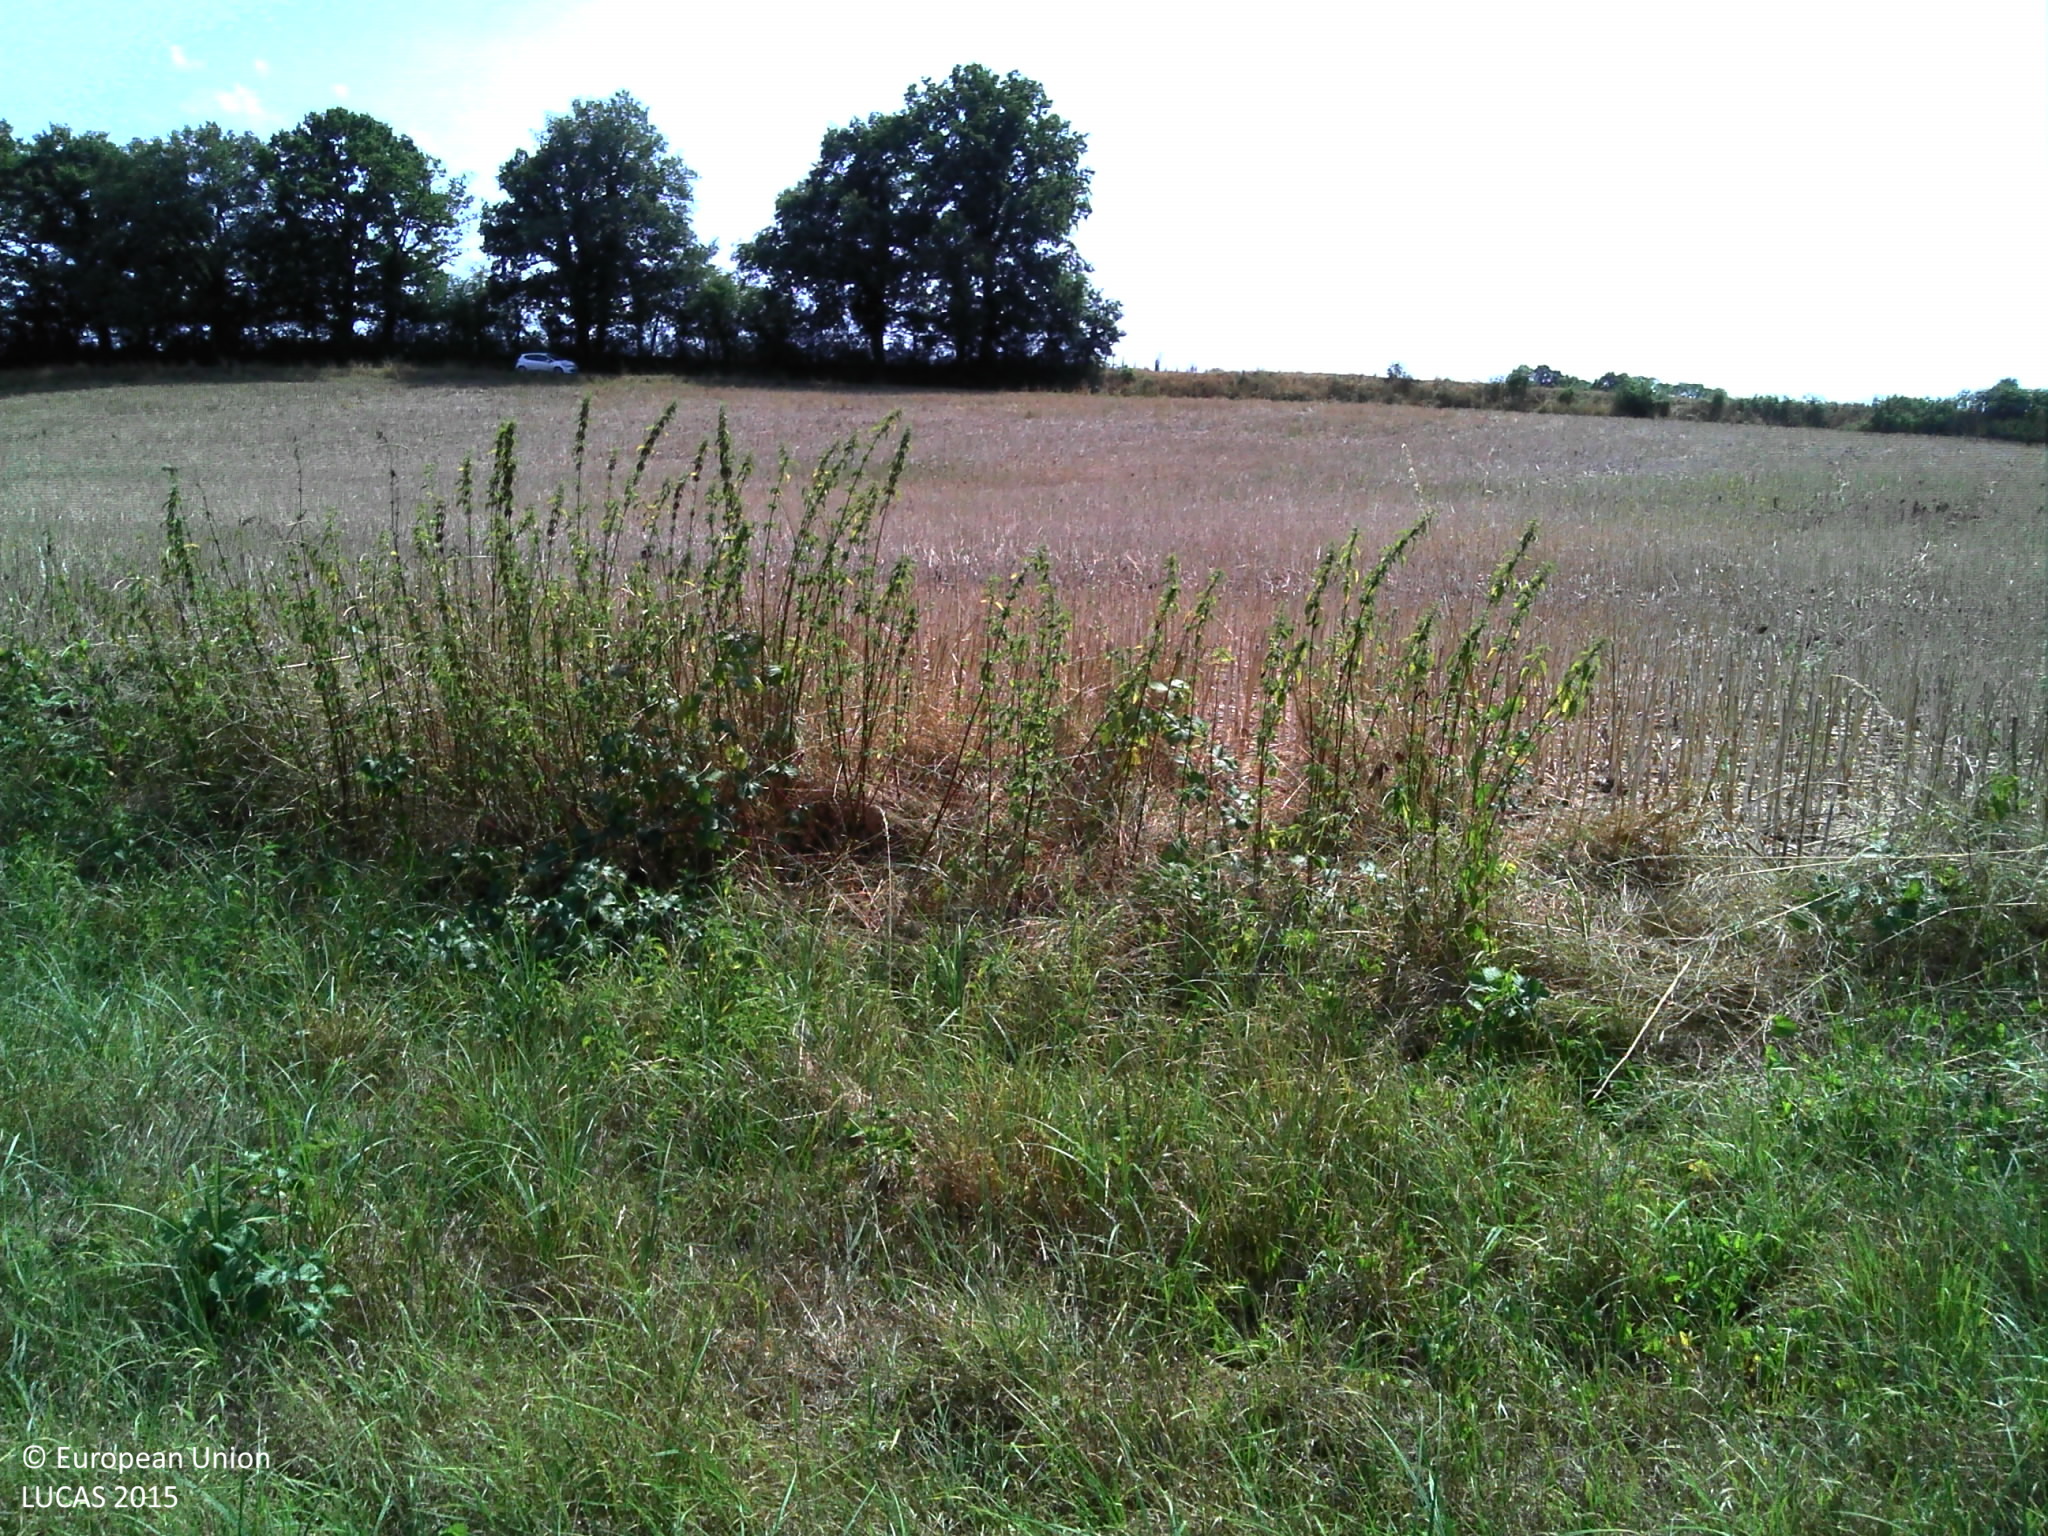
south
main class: Grassland
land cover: Grassland without tree/shrub cover
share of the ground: > 75 %
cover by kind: herbaceous plants 100 %
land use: Agriculture (excluding fallow land and kitchen gardens)
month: August
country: FR
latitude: 47.8113
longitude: 3.1434
